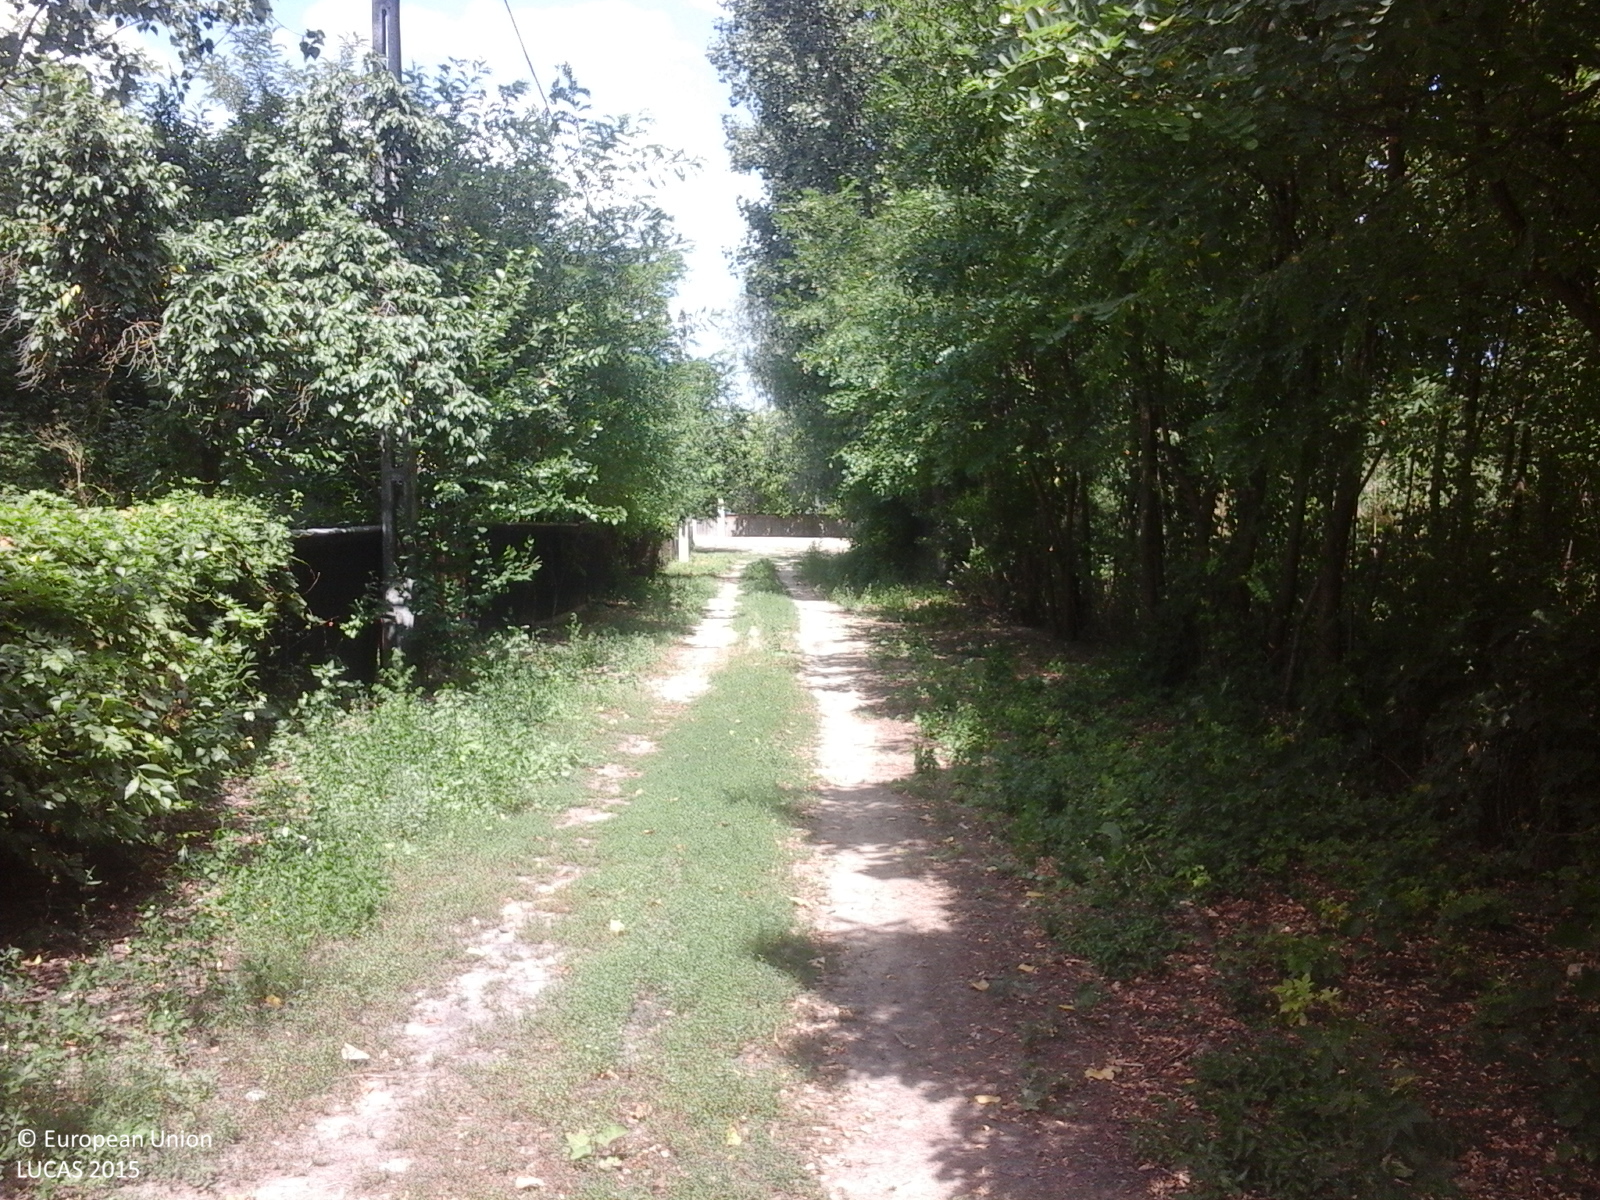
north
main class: Woodland
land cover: Broadleaved woodland
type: exotic forest
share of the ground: > 75 %
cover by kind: broadleaved forest trees 100 %
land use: Agriculture (excluding fallow land and kitchen gardens)
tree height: > 5 m
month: July
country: RO
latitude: 46.4834
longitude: 28.2273
